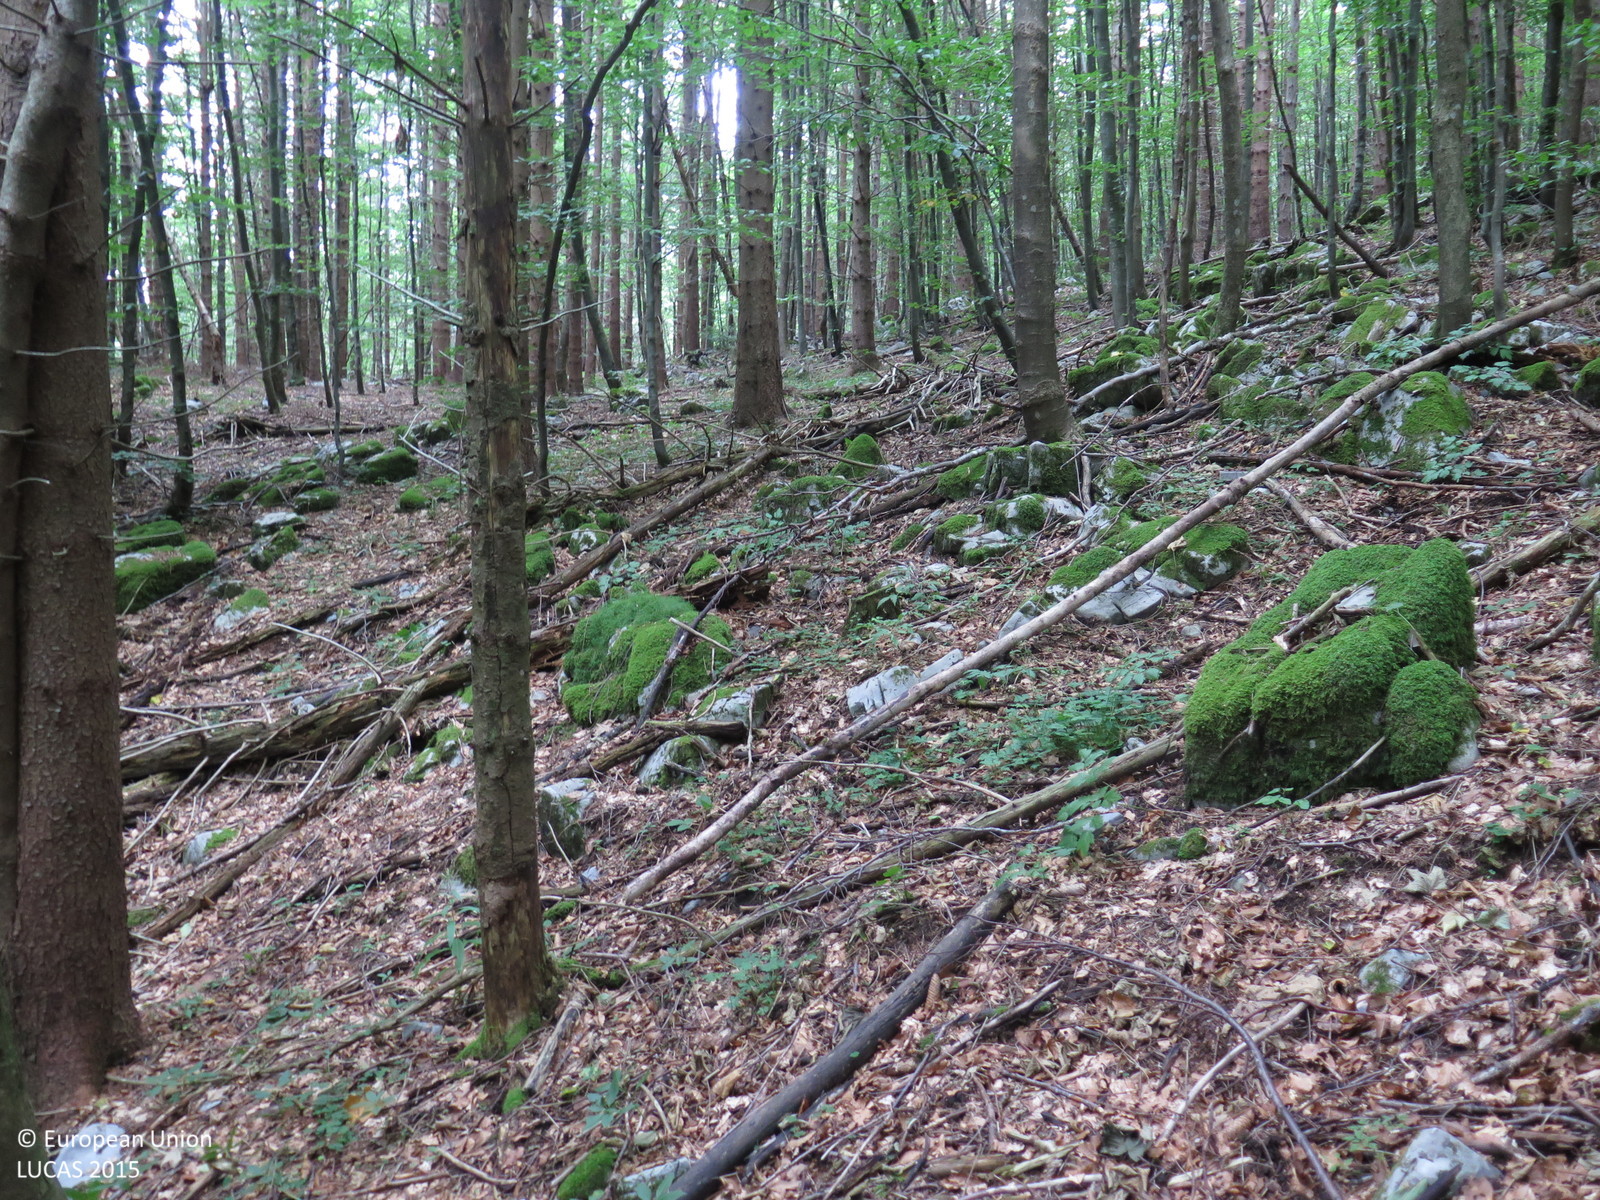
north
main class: Woodland
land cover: Other mixed woodland
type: mountainous beech forest
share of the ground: > 75 %
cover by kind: broadleaved forest trees 75 %, coniferous forest trees 25 %
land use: Forestry
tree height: > 5 m
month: August
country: HR
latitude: 45.1180
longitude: 14.9396
